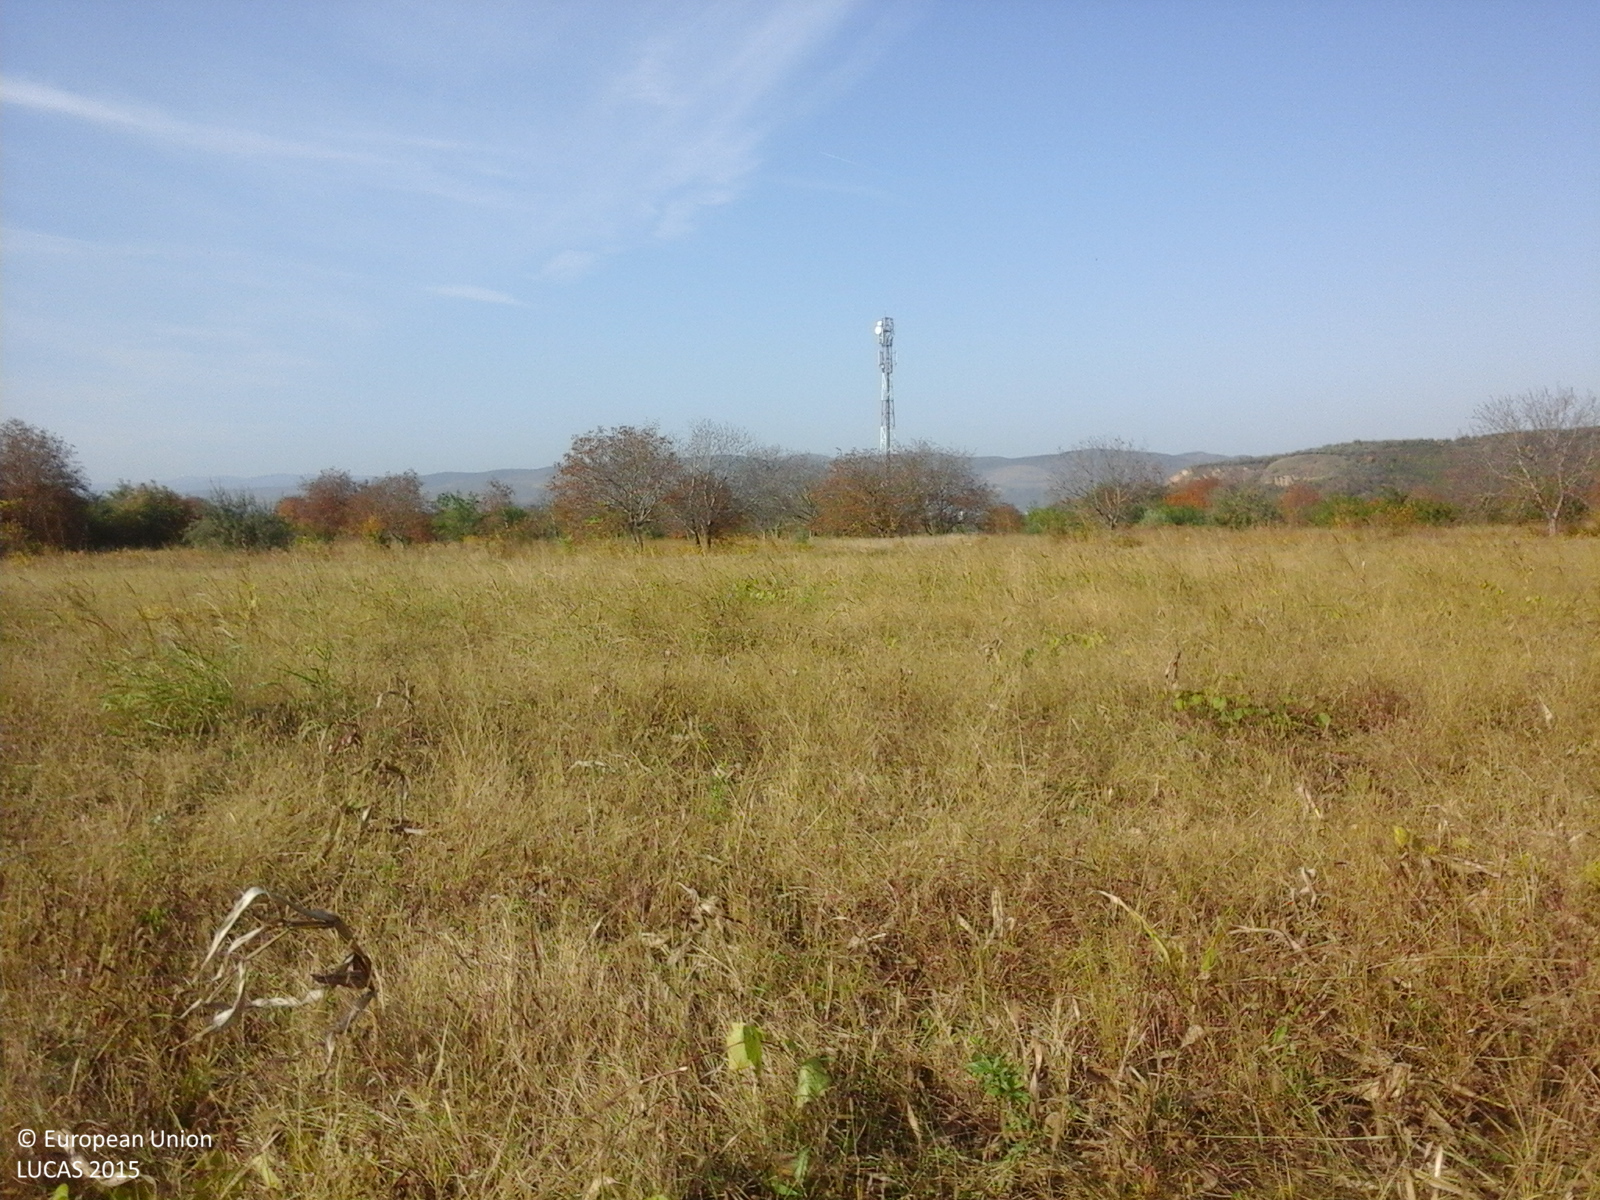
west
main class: Cropland
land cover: Maize
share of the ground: > 75 %
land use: Agriculture (excluding fallow land and kitchen gardens)
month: October
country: RO
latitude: 45.2383
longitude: 26.7539
